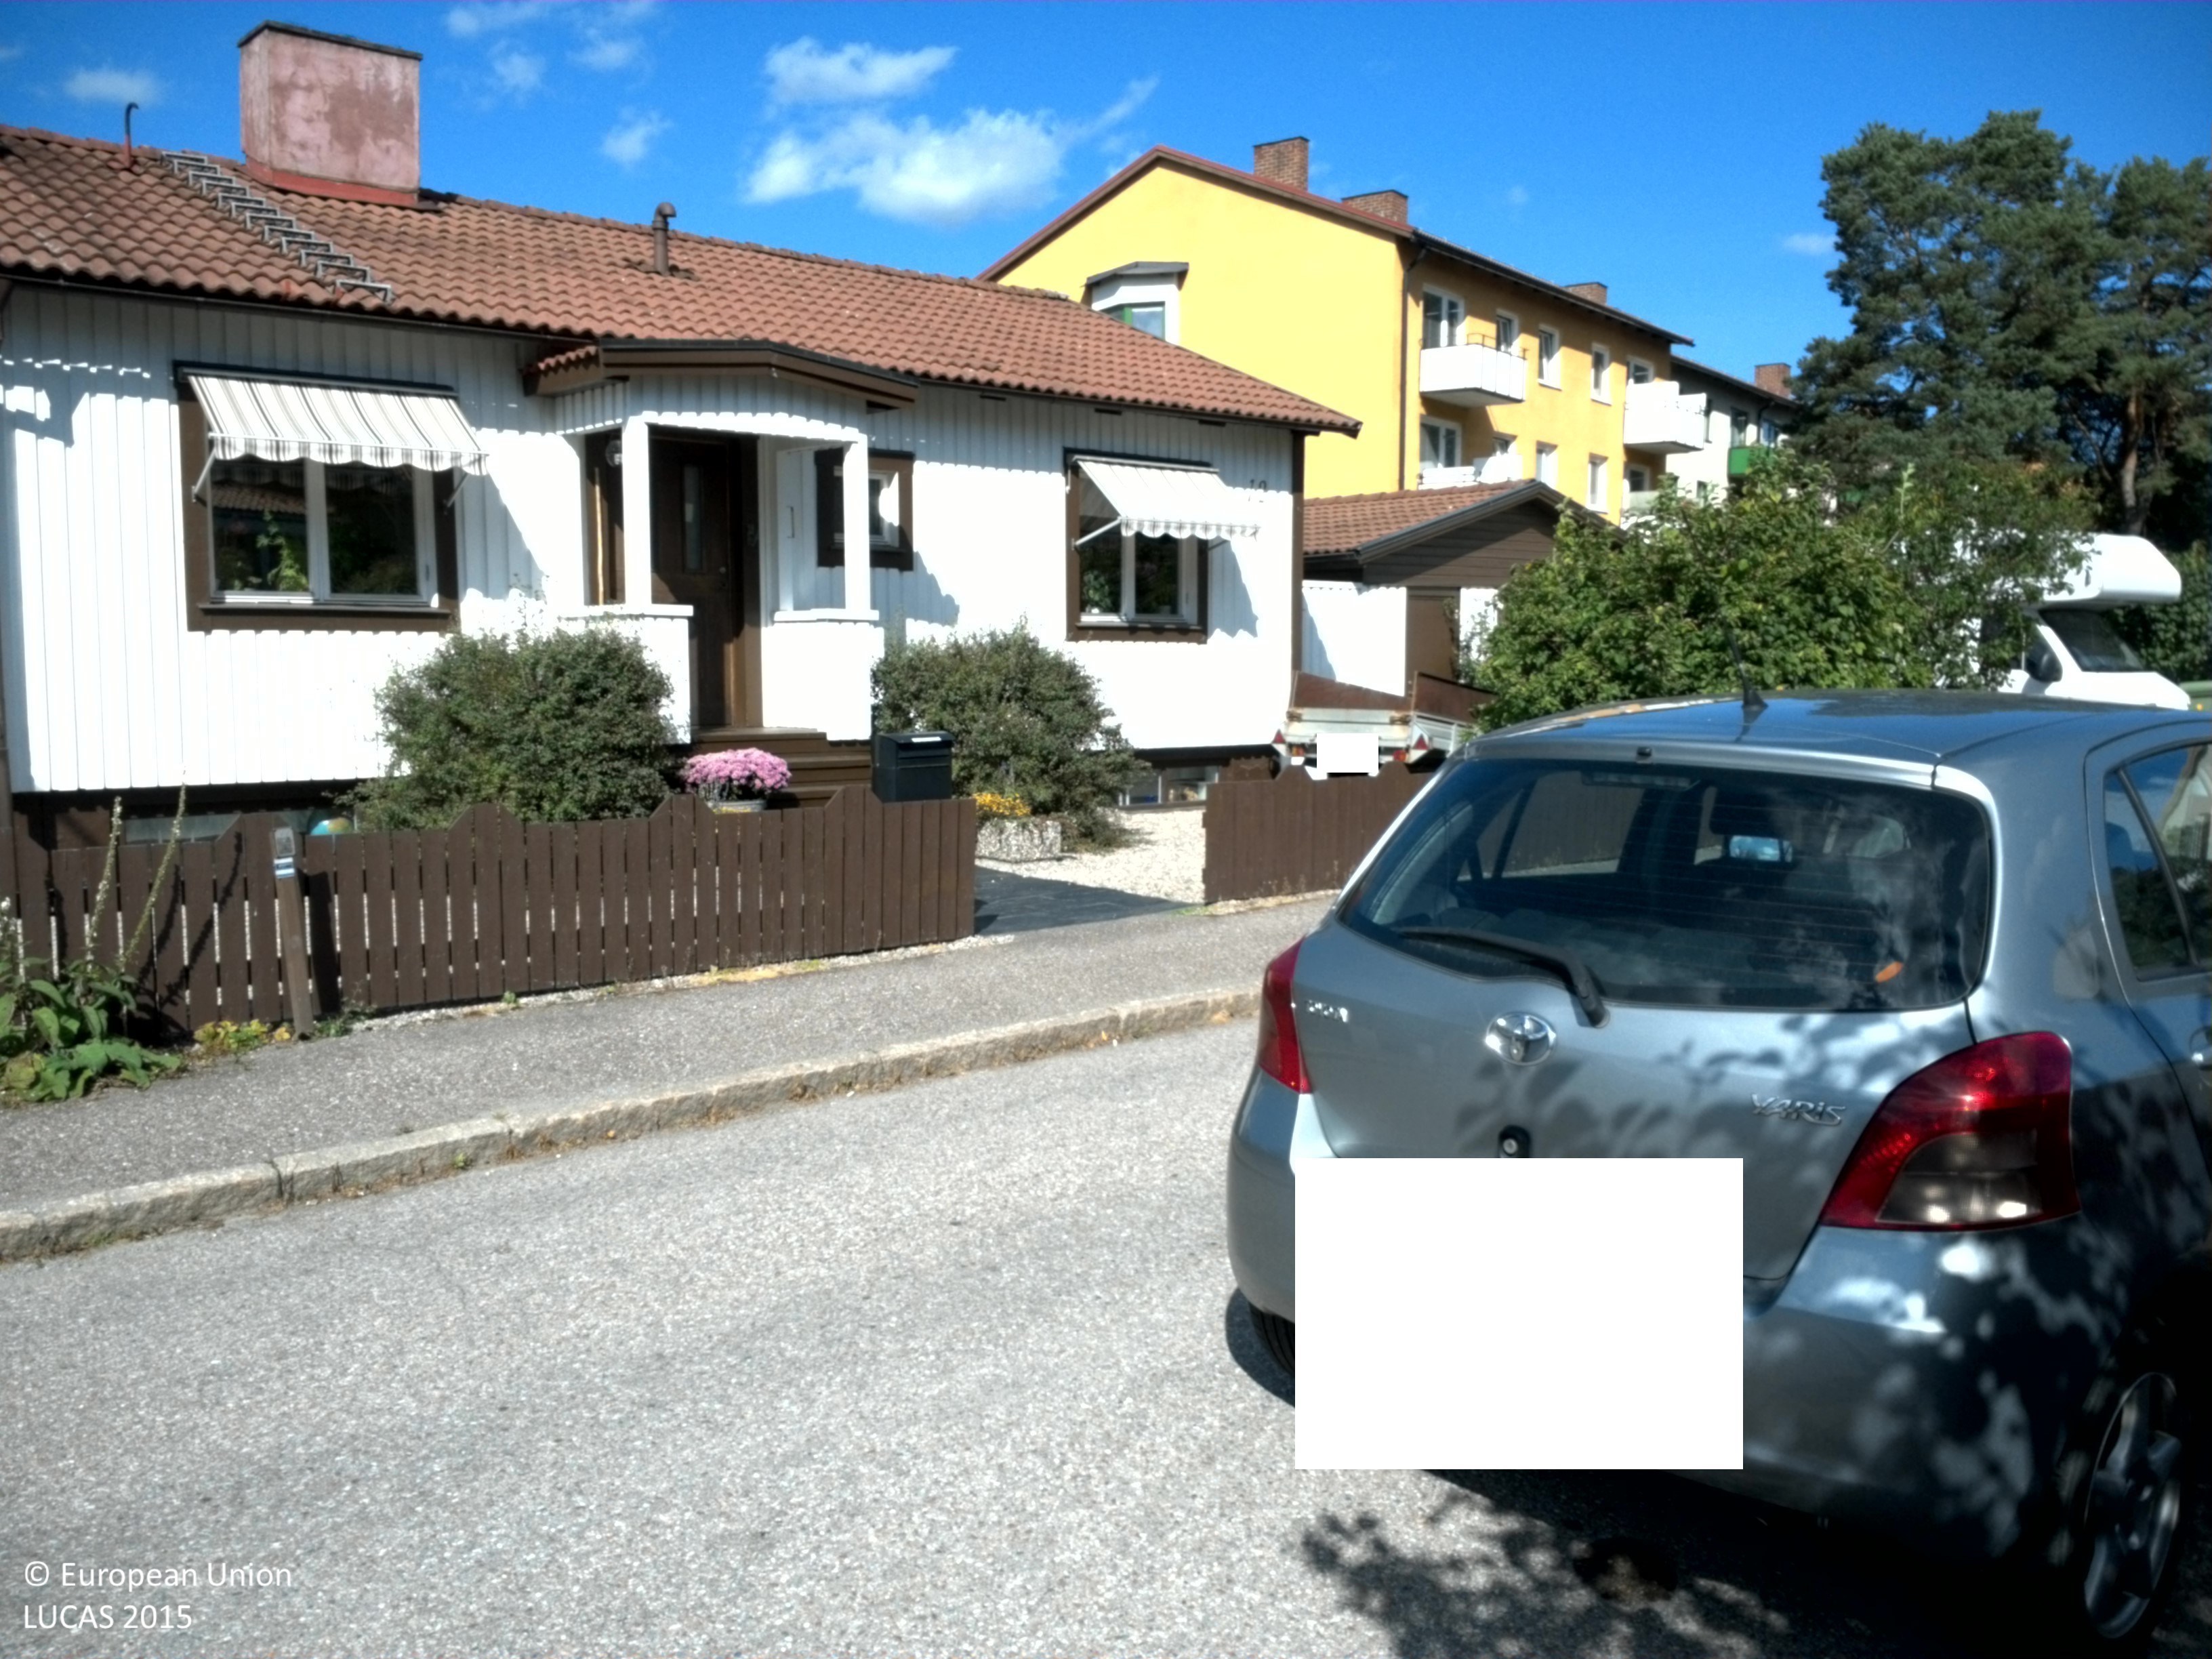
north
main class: Grassland
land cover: Grassland with sparse tree/shrub cover
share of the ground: > 75 %
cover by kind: herbaceous plants 95 %, broadleaved forest trees 5 %
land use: Residential
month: August
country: SE
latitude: 59.6399
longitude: 17.1063
